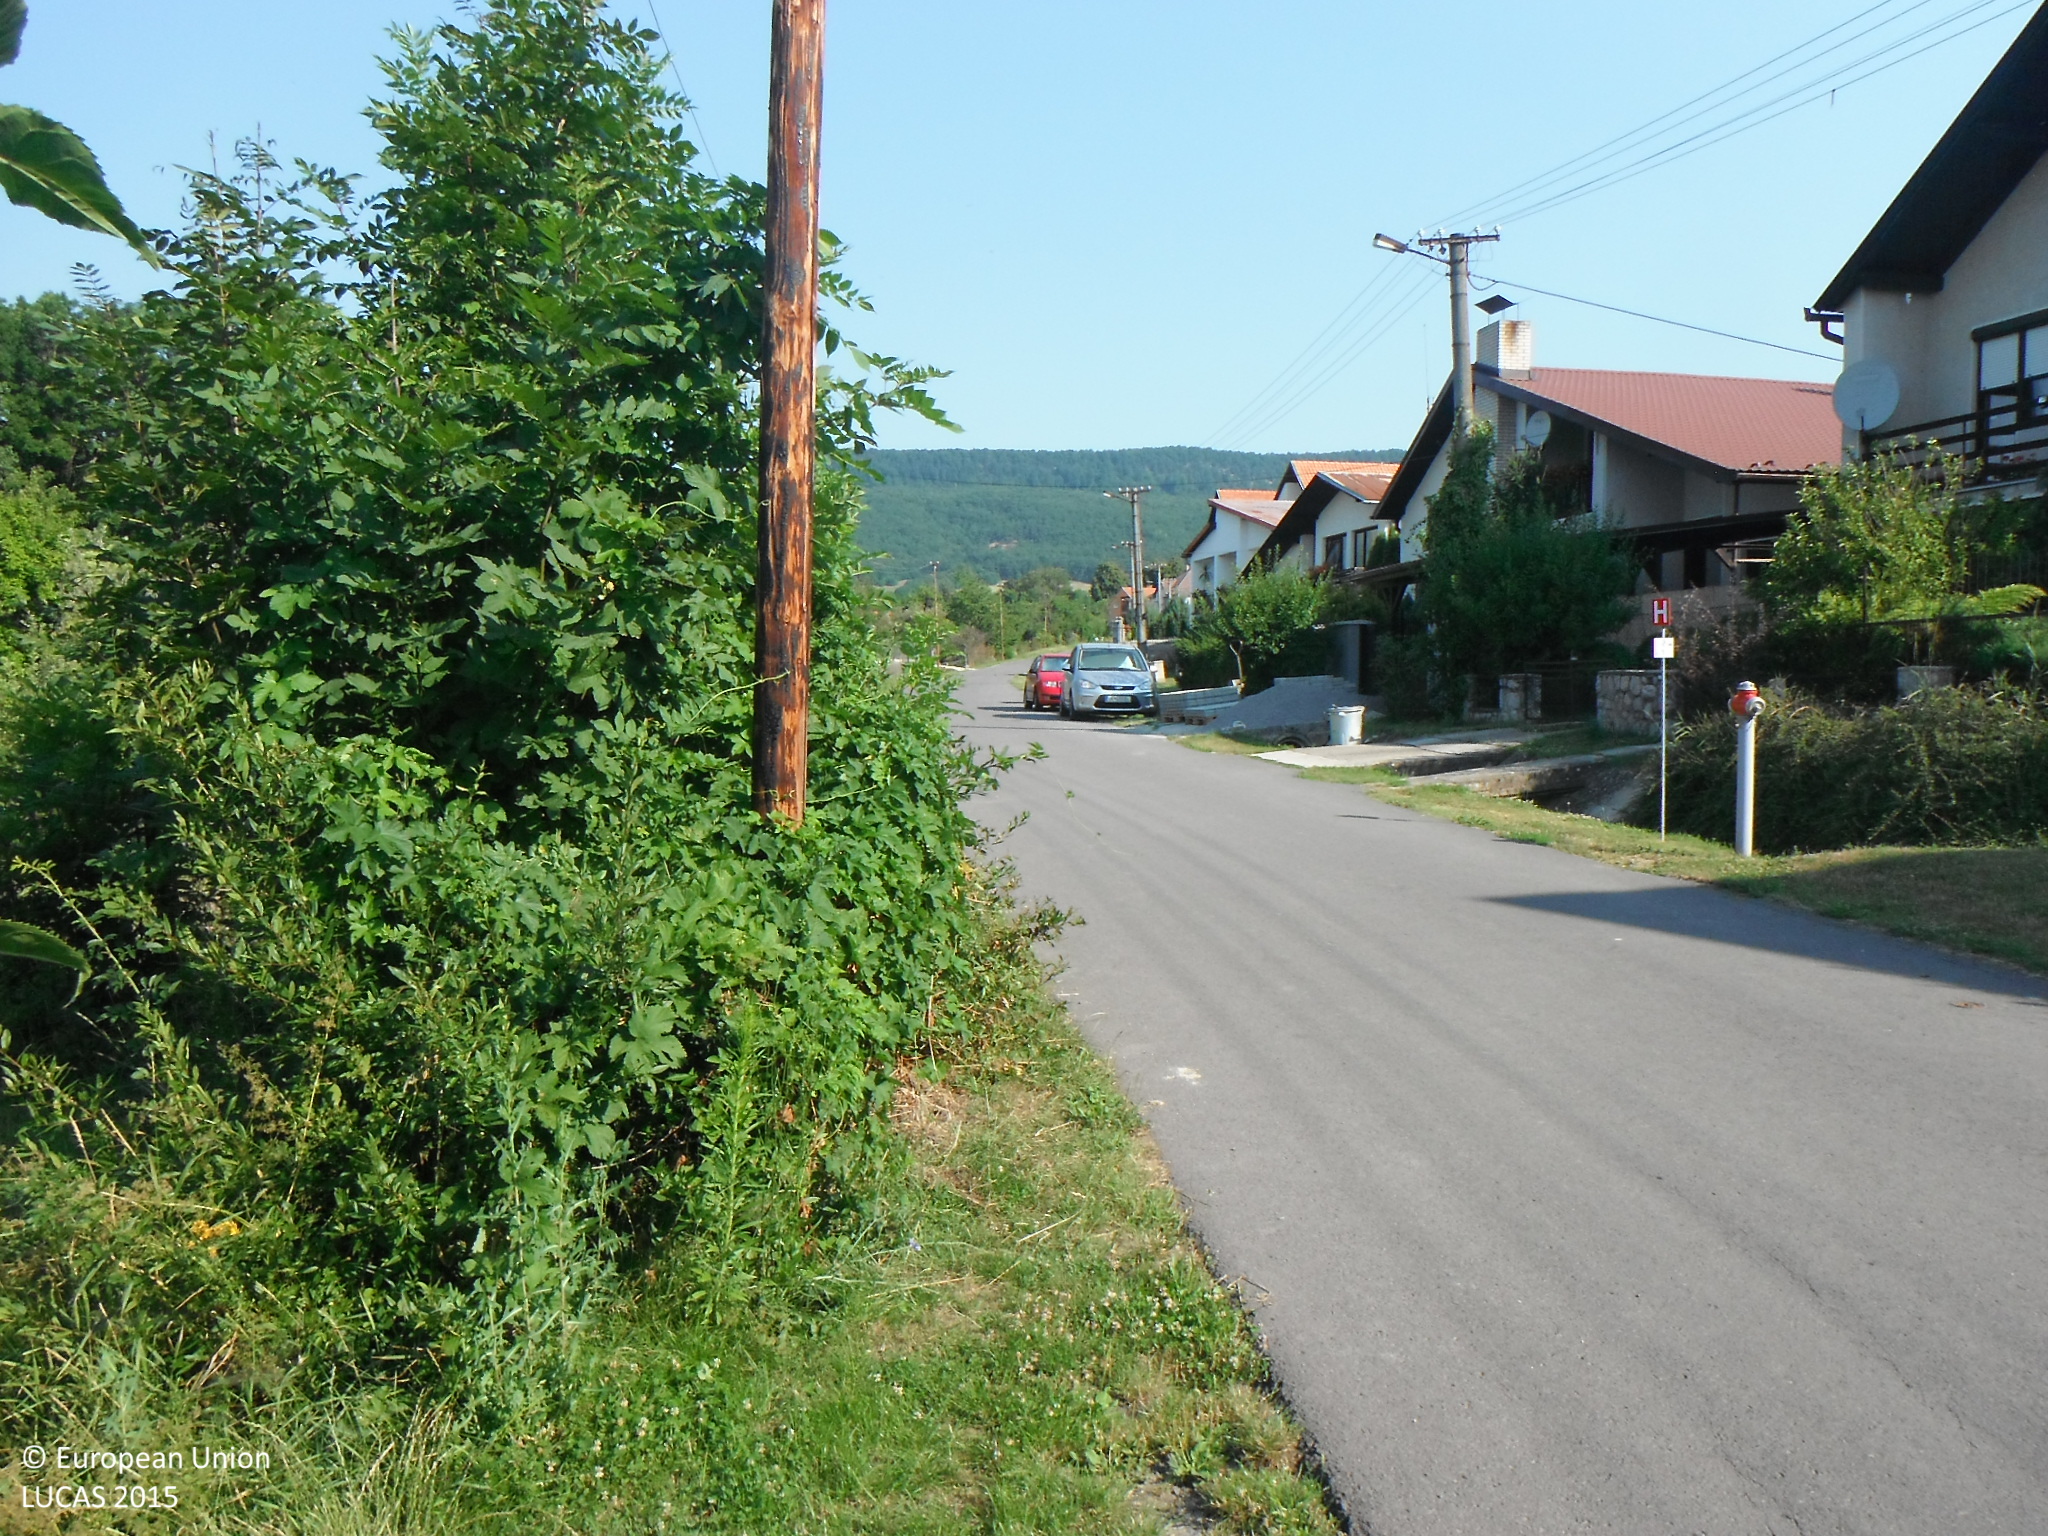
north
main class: Grassland
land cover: Grassland without tree/shrub cover
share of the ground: > 75 %
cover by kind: herbaceous plants 100 %
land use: Residential
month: July
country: SK
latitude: 48.1949
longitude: 19.2643
